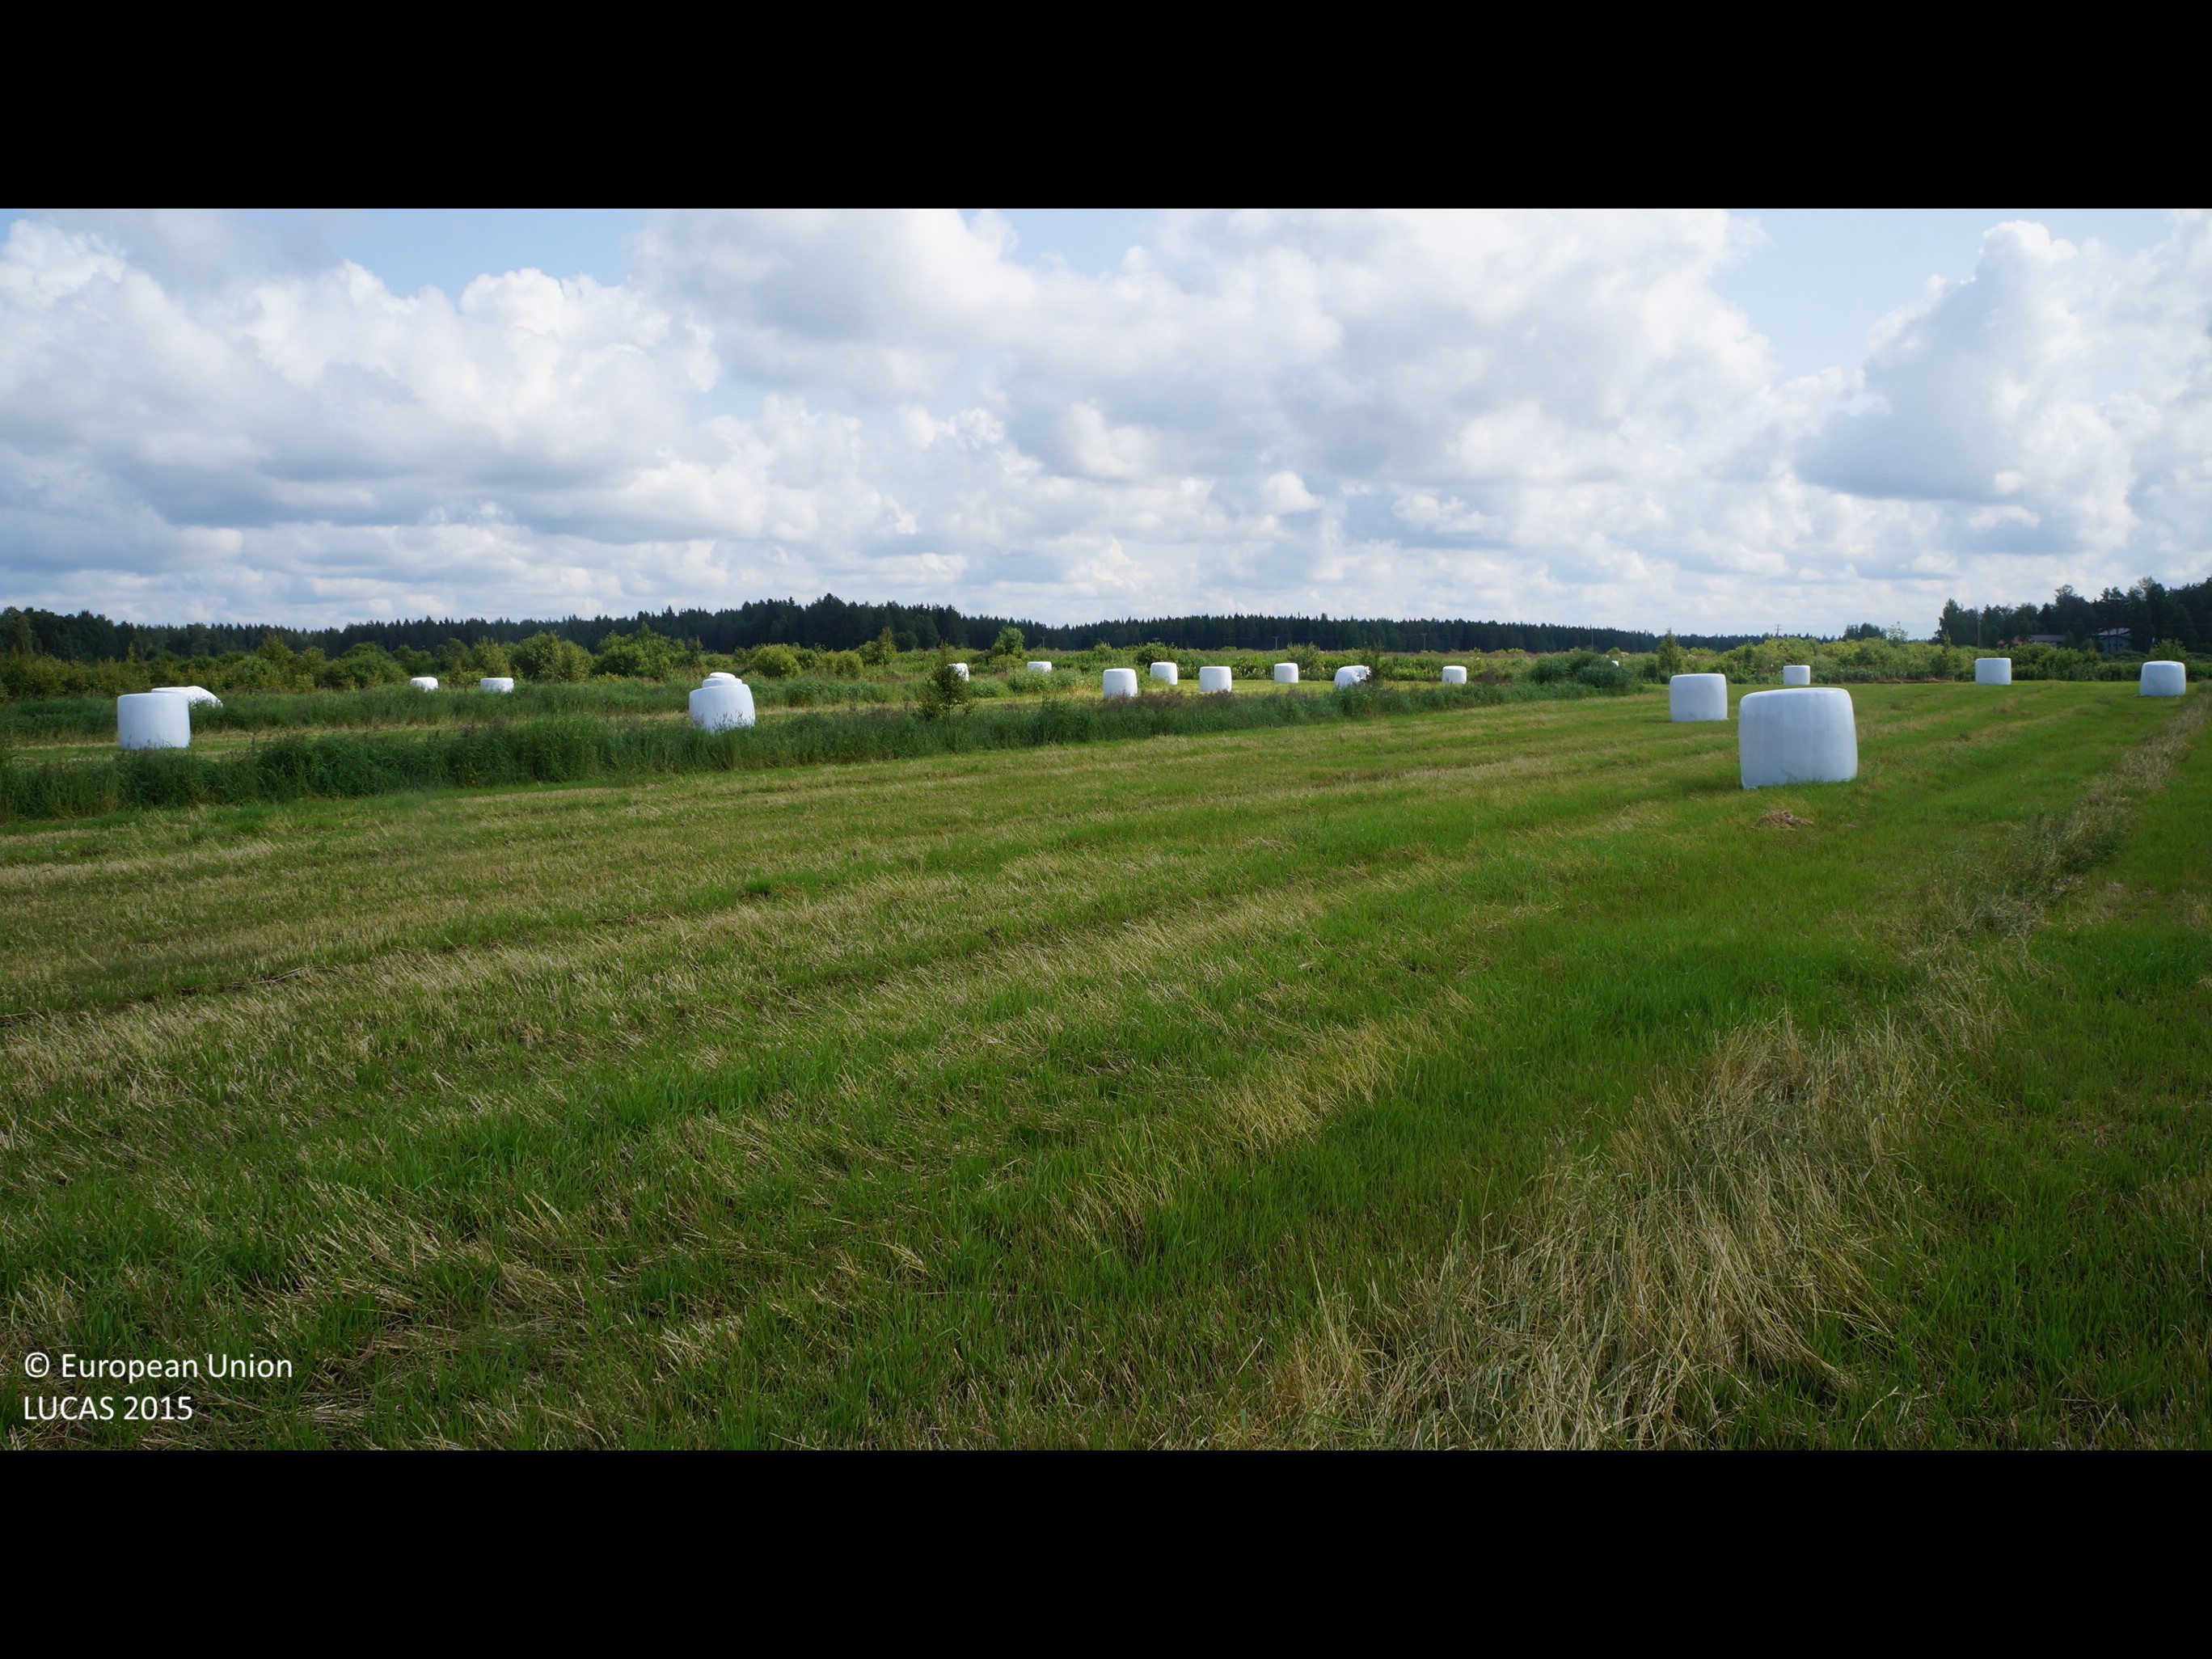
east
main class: Cropland
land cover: Temporary grasslands
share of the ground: > 75 %
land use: Agriculture (excluding fallow land and kitchen gardens)
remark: Harvested field
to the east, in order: Temporary grasslands; Grass margins; Ditches and canals; Grass margins; Temporary grasslands; Shruby margins; Ditches and canals; Shruby margins; Temporary grasslands; Shruby margins; Ditches and canals; Shruby margins; Temporary grasslands; Shruby margins; Ditches and canals; Shruby margins; Arable land (only in case pi)
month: July
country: FI
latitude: 64.1601
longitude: 24.4039
